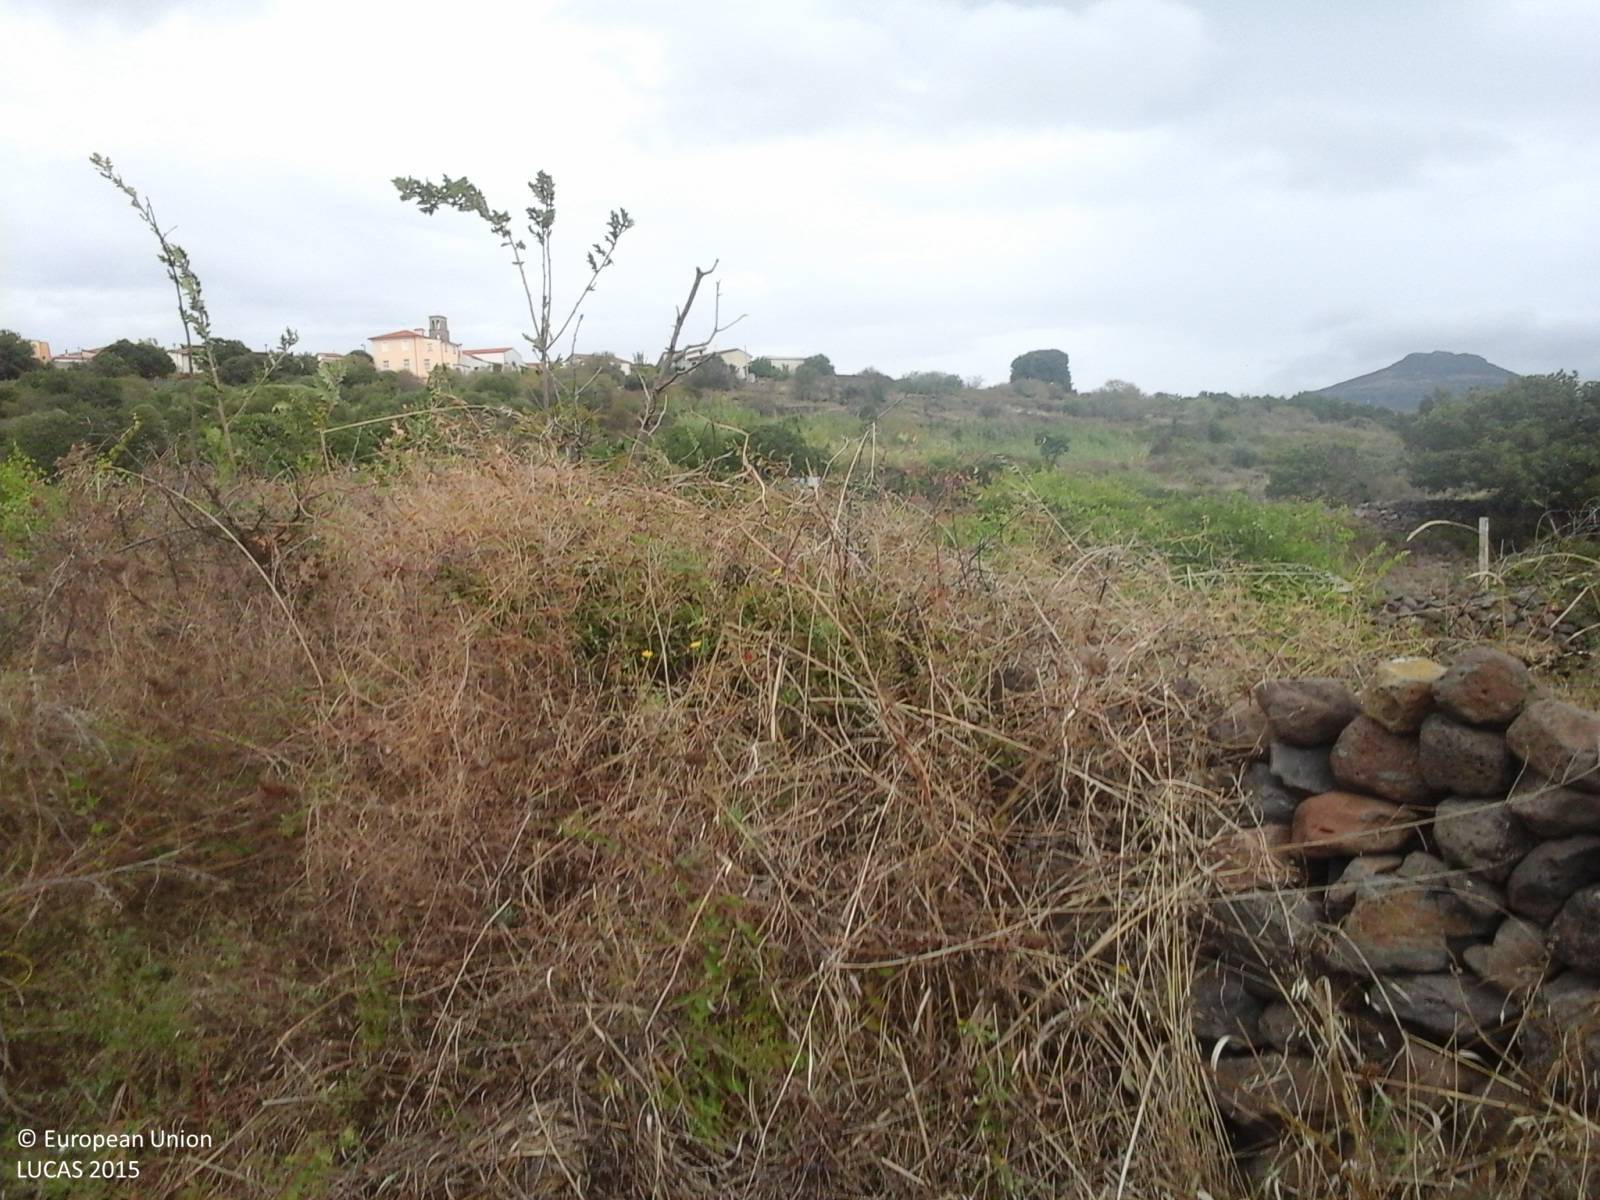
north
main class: Grassland
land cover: Grassland without tree/shrub cover
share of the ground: > 75 %
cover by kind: herbaceous plants 100 %
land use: Agriculture (excluding fallow land and kitchen gardens)
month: September
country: IT
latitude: 40.2602
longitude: 8.8186
